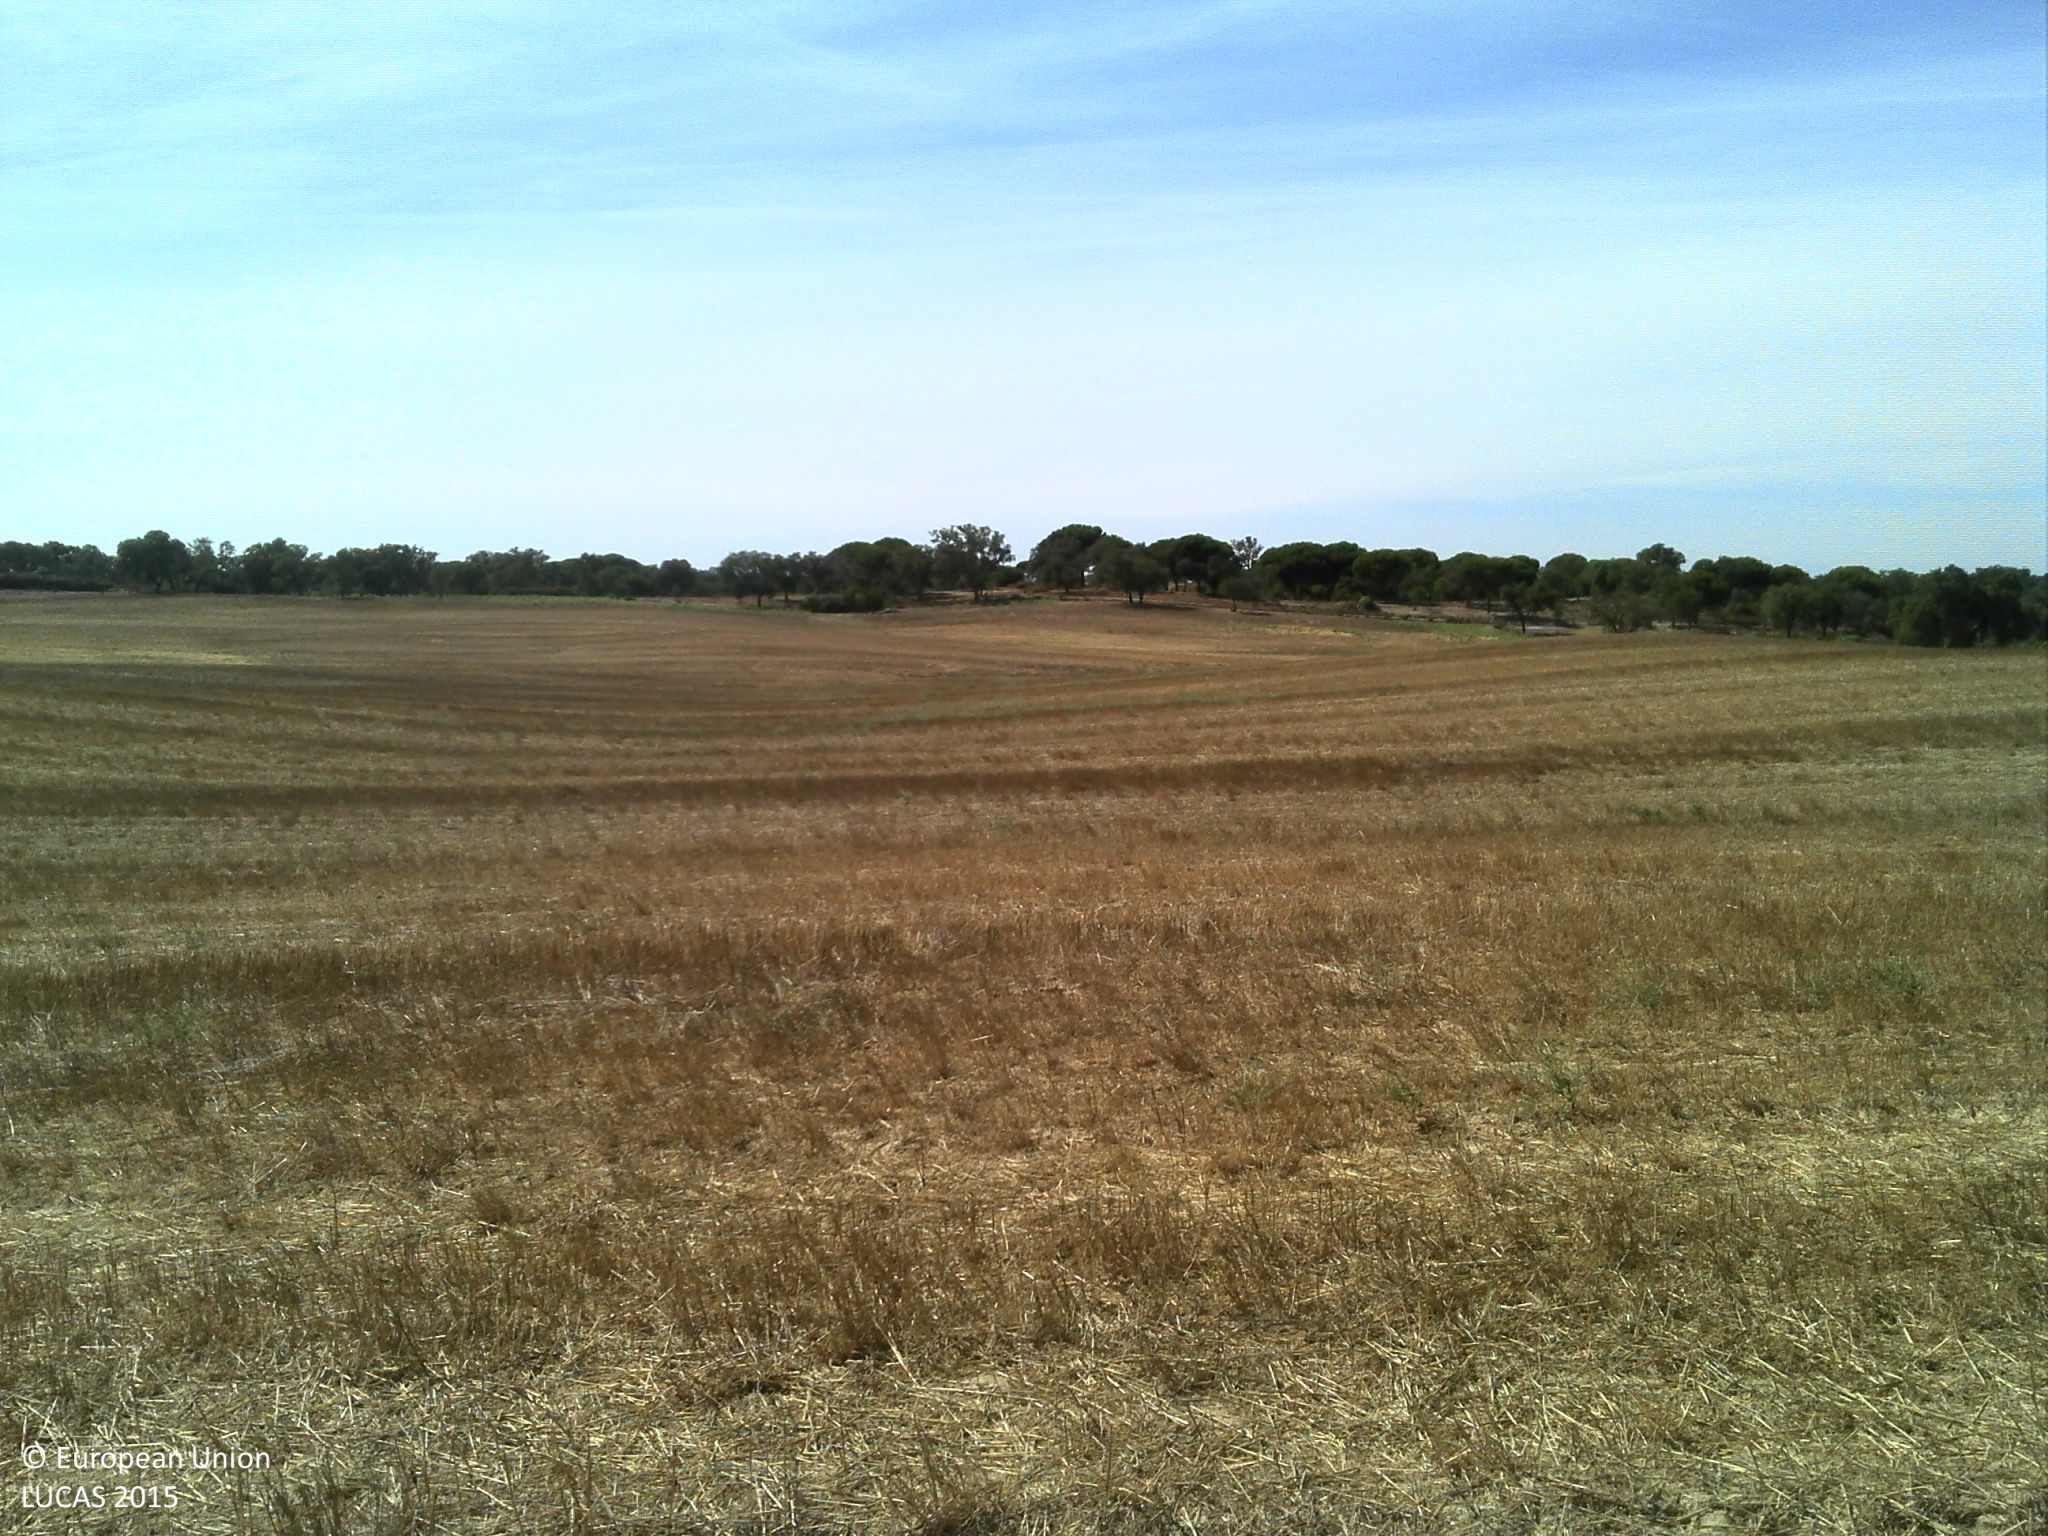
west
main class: Cropland
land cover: Common wheat
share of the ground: < 10 %
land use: Agriculture (excluding fallow land and kitchen gardens)
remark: Harvested field
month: August
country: PT
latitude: 38.7229
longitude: -8.5422
